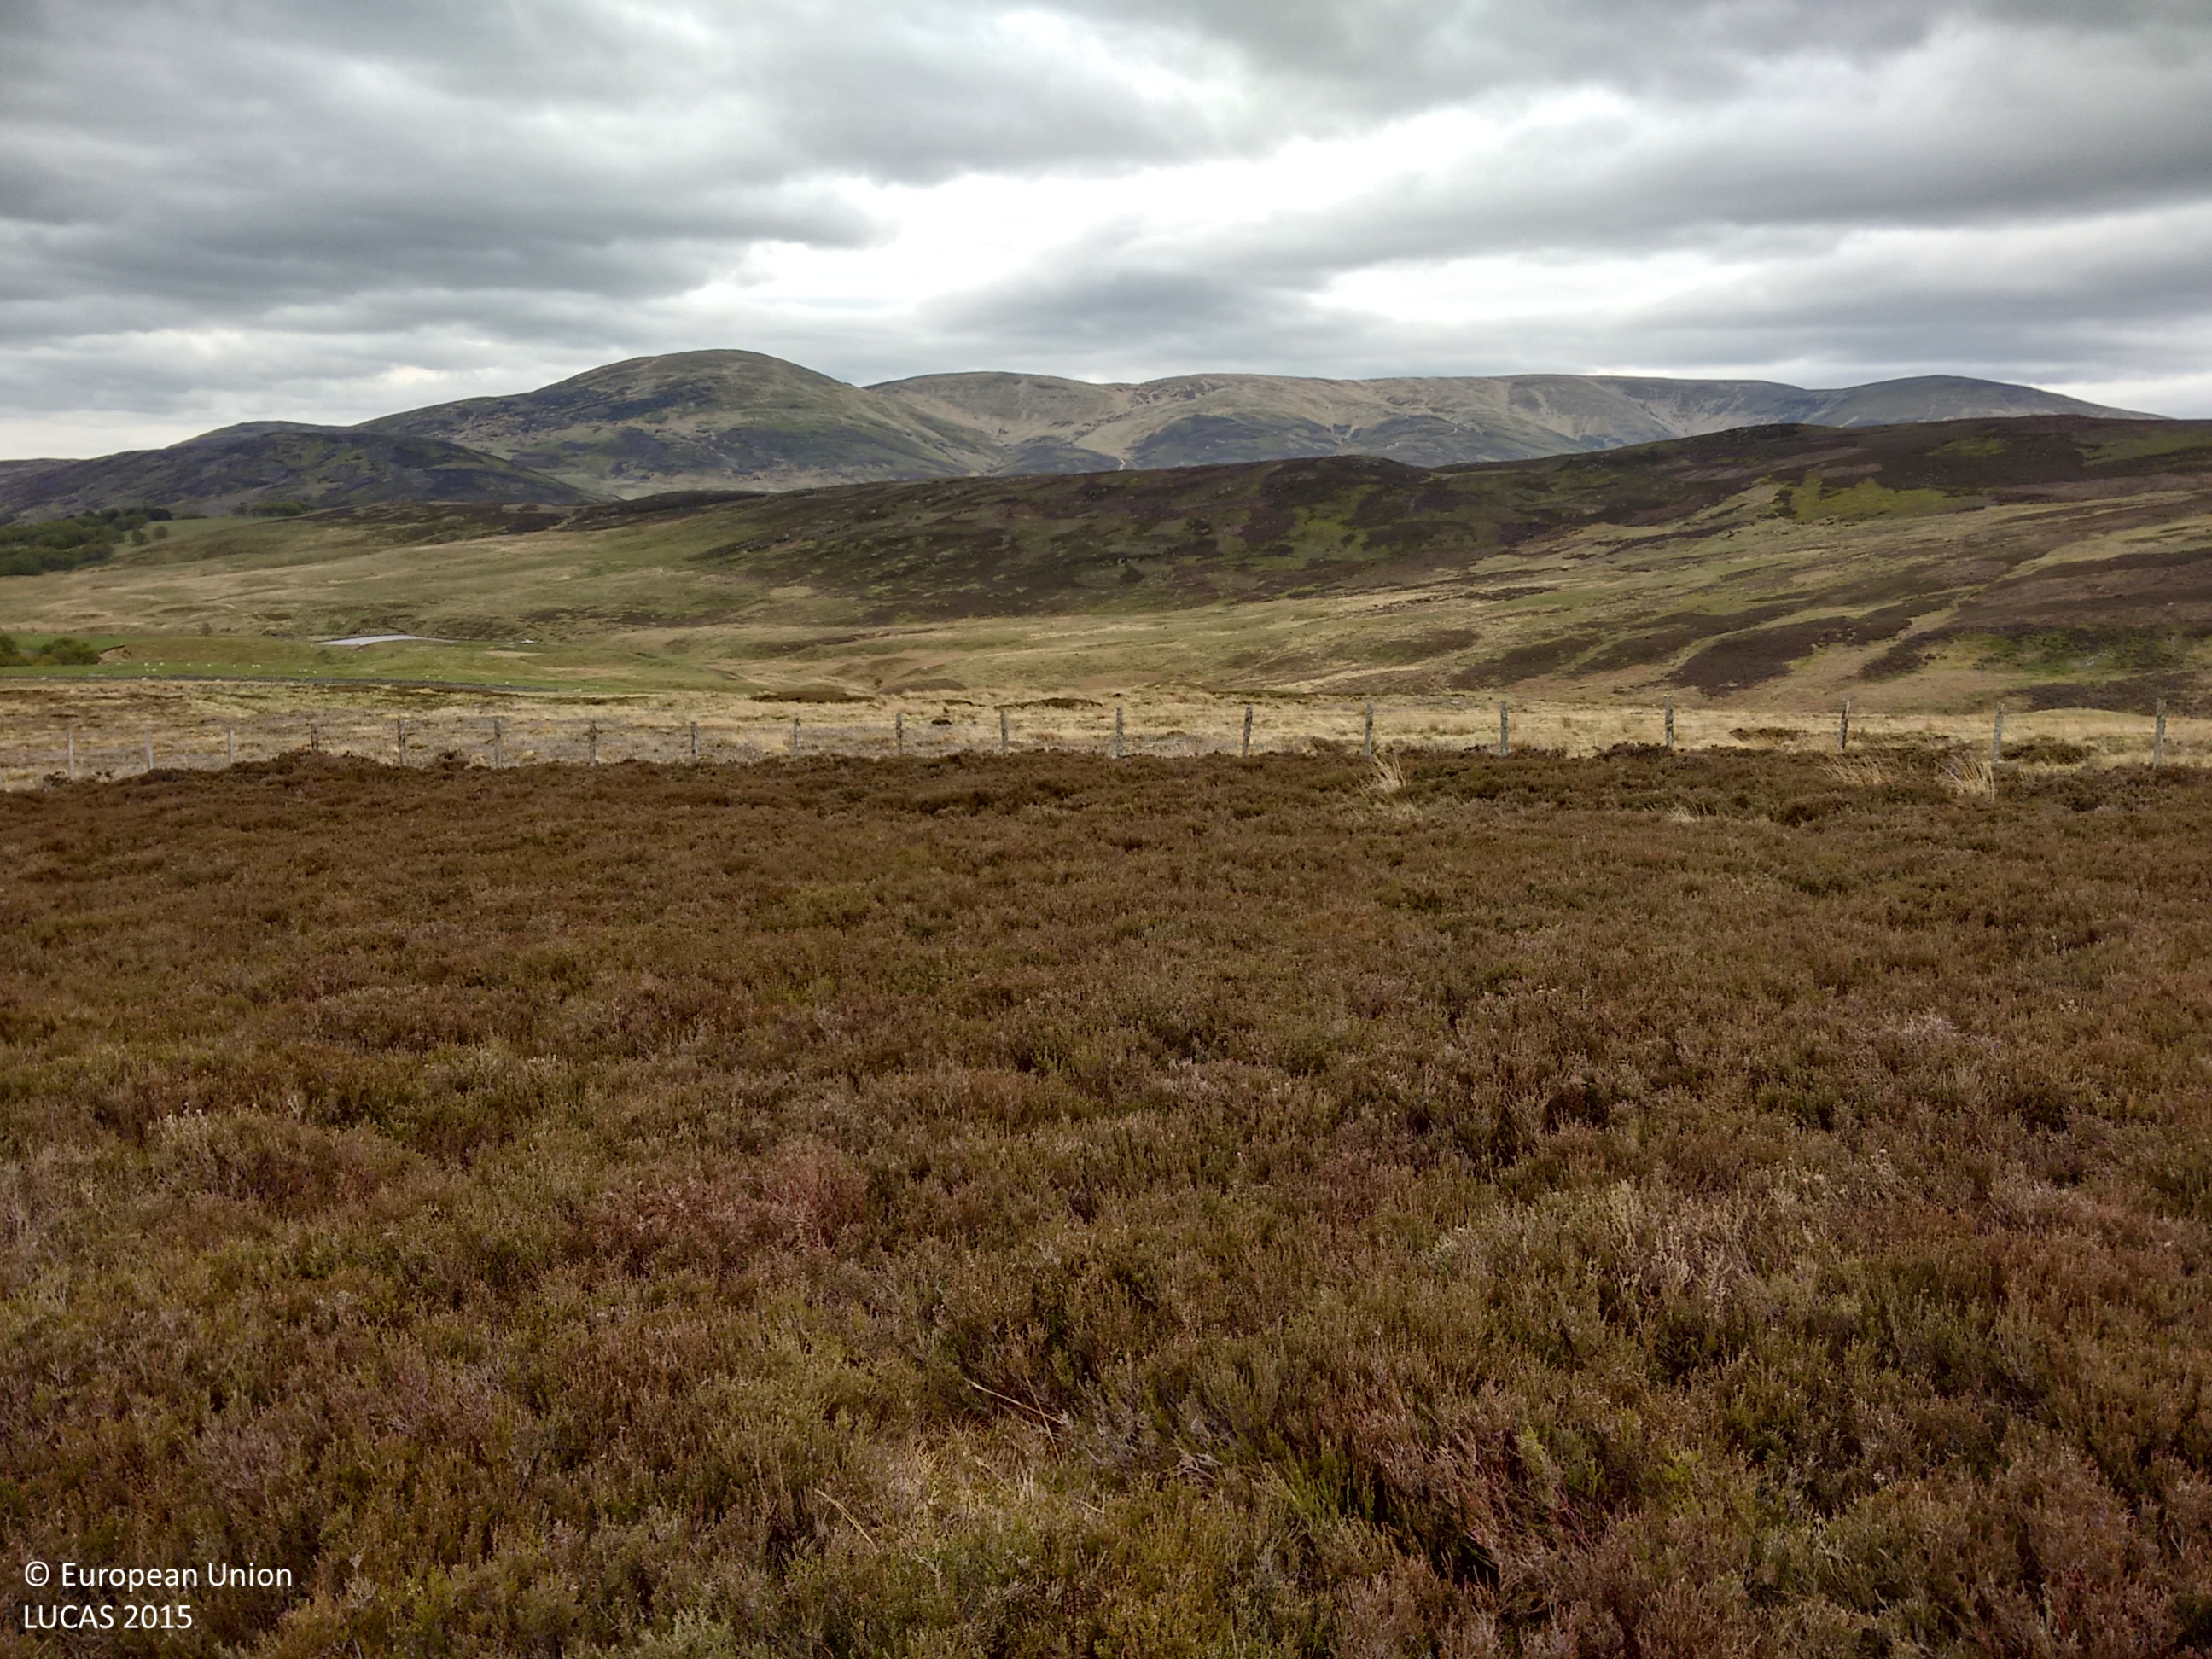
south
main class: Shrubland
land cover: Shrubland without tree cover
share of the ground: > 75 %
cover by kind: shrubs 95 %, herbaceous plants 5 %
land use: Semi-natural and natural areas not in use
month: May
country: GB
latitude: 56.9120
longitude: -2.7889
